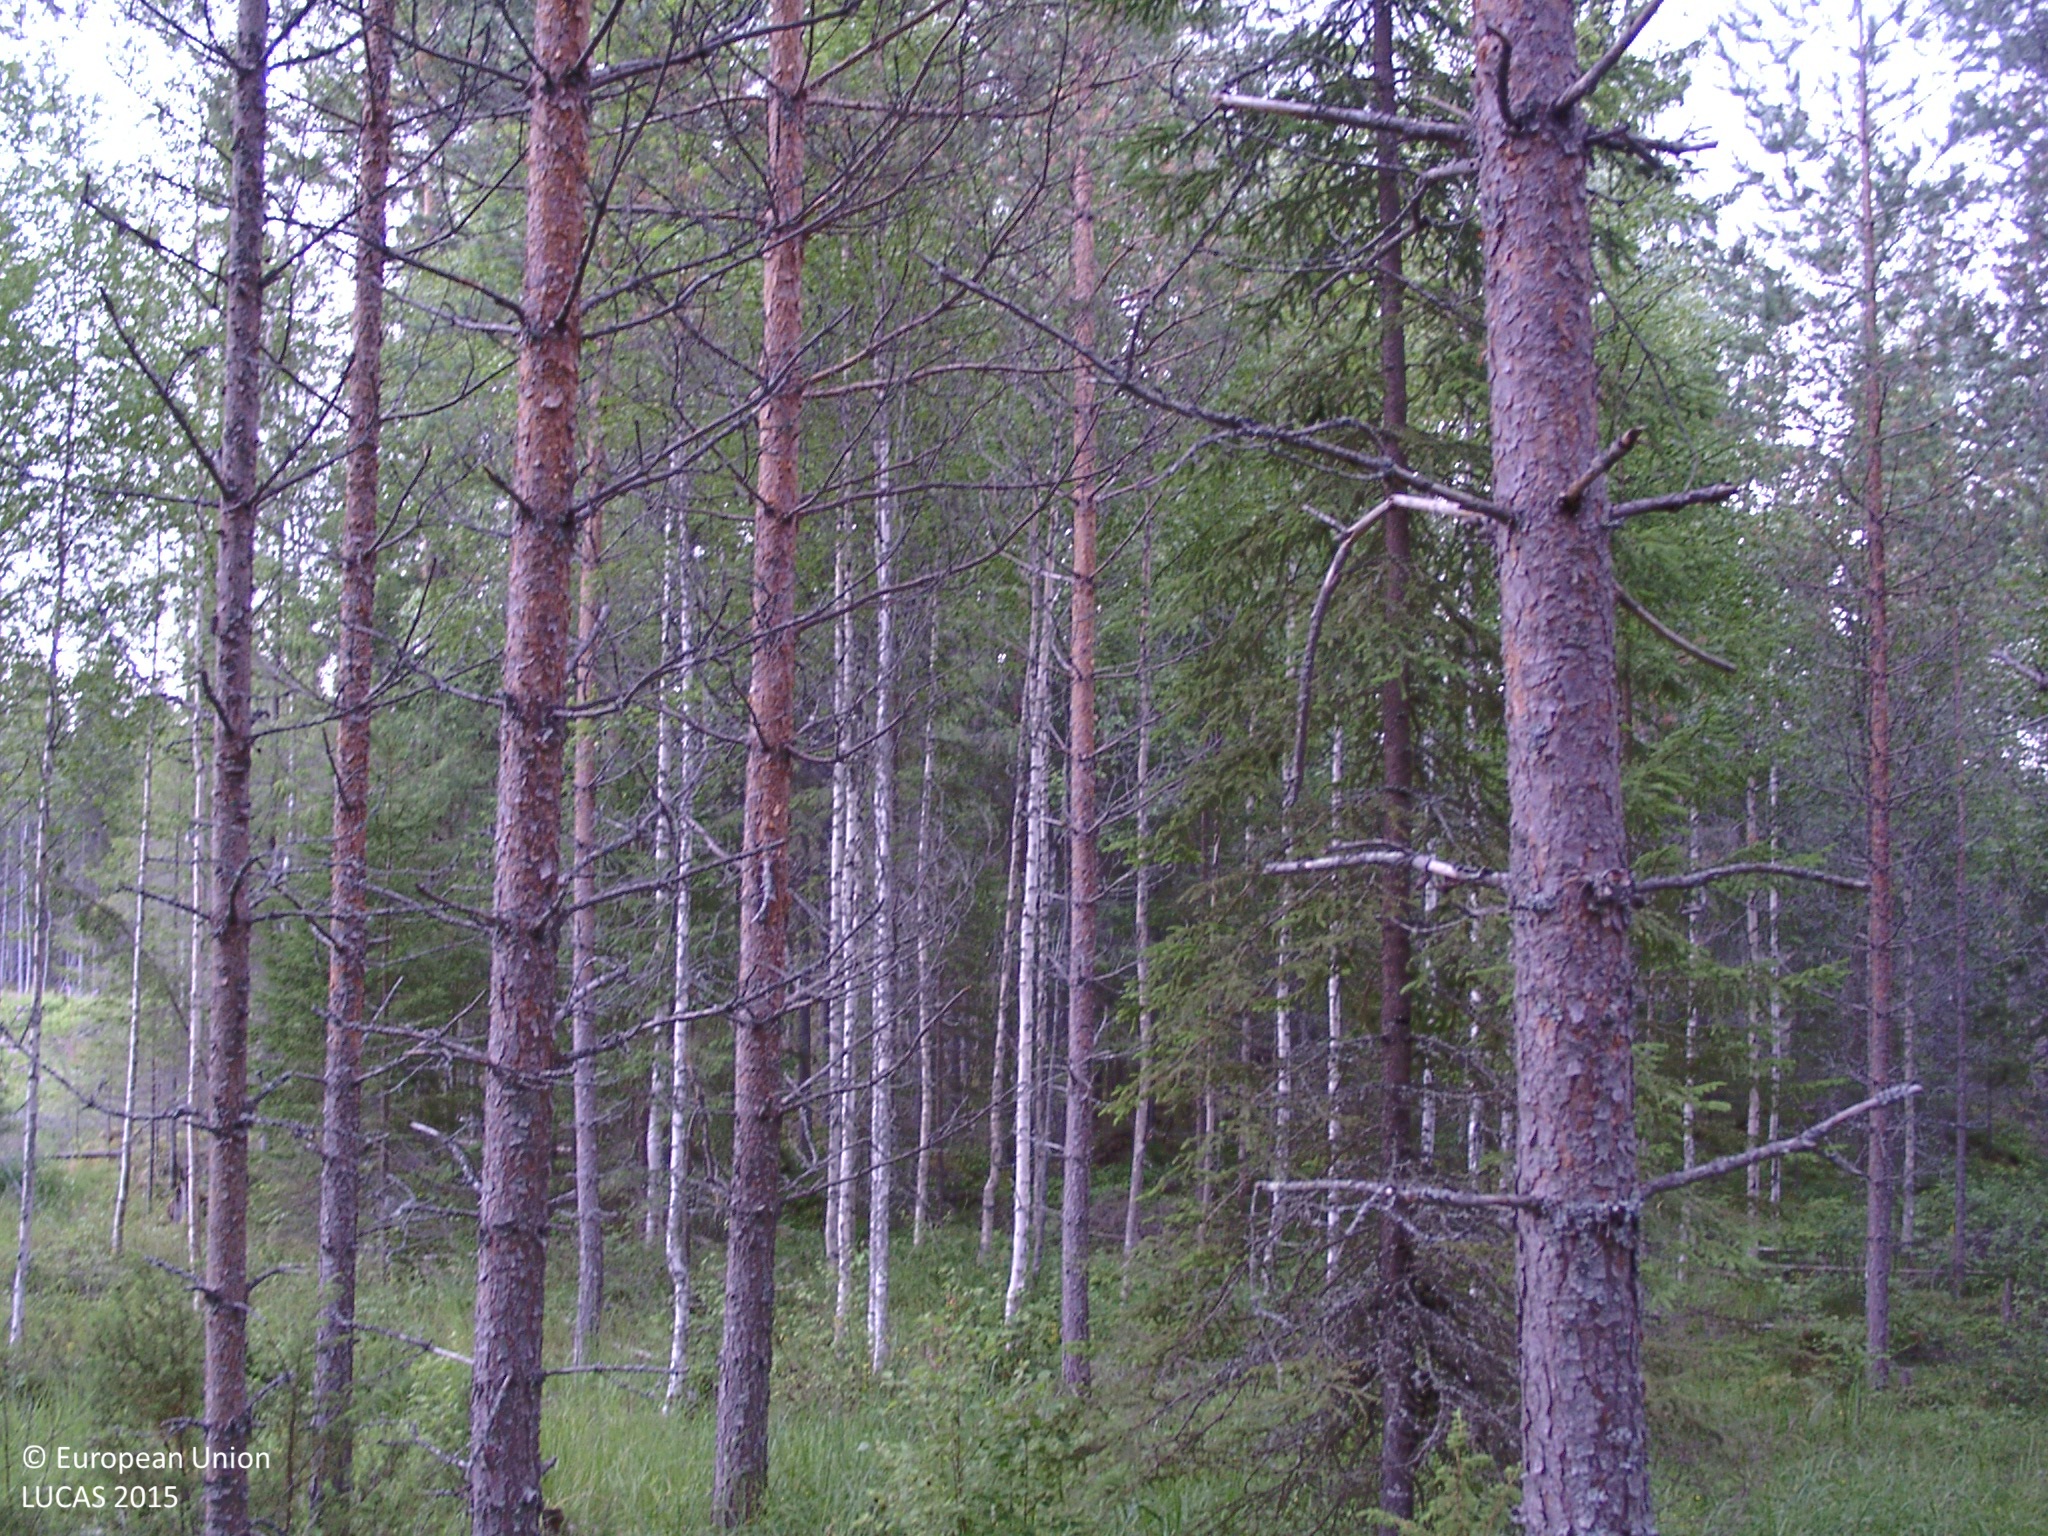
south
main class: Woodland
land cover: Other mixed woodland
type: boreal forest
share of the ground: 50 - 75 %
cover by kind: coniferous forest trees 45 %, broadleaved forest trees 25 %, shrubs 15 %, lichens and mosses 10 %, herbaceous plants 5 %
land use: Forestry
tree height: > 5 m
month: July
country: FI
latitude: 62.3157
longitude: 25.1743
